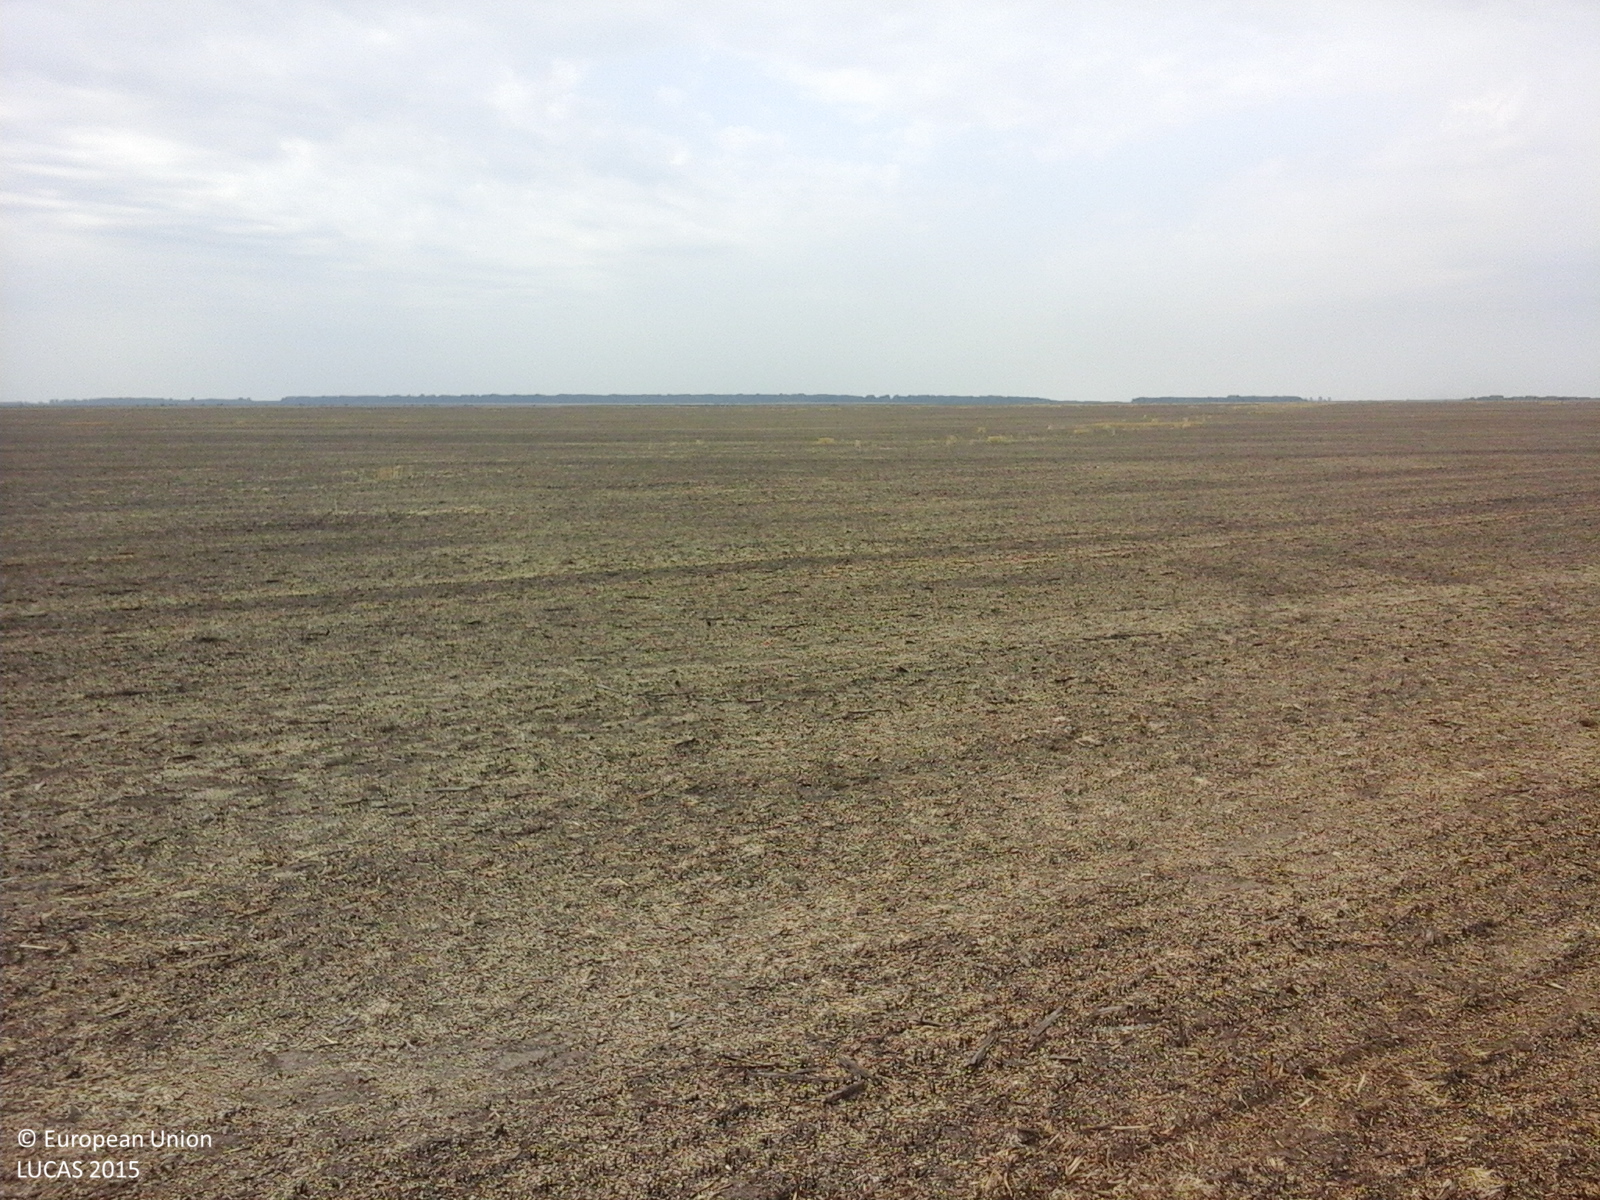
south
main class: Cropland
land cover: Sunflower
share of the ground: > 75 %
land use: Agriculture (excluding fallow land and kitchen gardens)
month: August
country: RO
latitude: 43.9533
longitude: 28.4456
